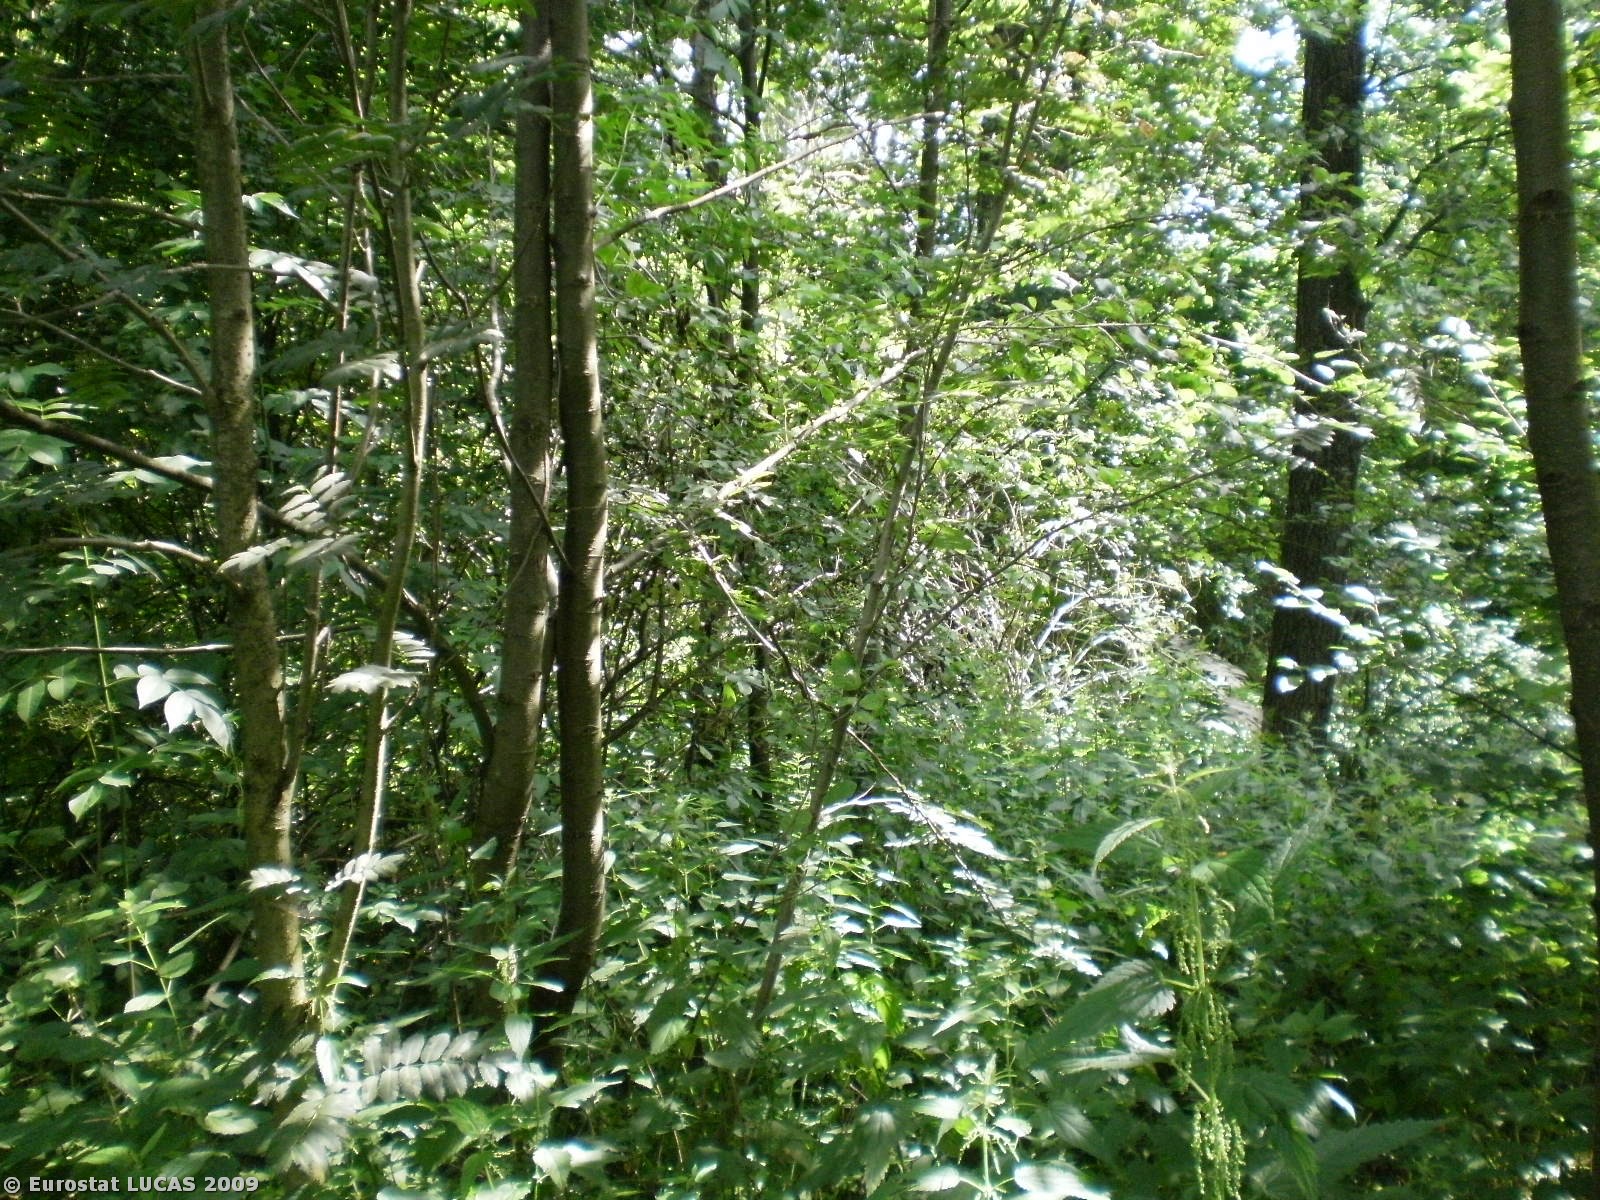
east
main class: Woodland
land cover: Broadleaved woodland
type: mire and swamp forests
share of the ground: > 75 %
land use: Forestry
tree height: > 5 m
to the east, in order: Broadleaved woodland; Grassland with sparse tree/shrub cover; Grassland without tree/shrub cover; Ditches and canals; Grassland without tree/shrub cover
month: July
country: PL
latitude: 54.0379
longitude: 20.0020
